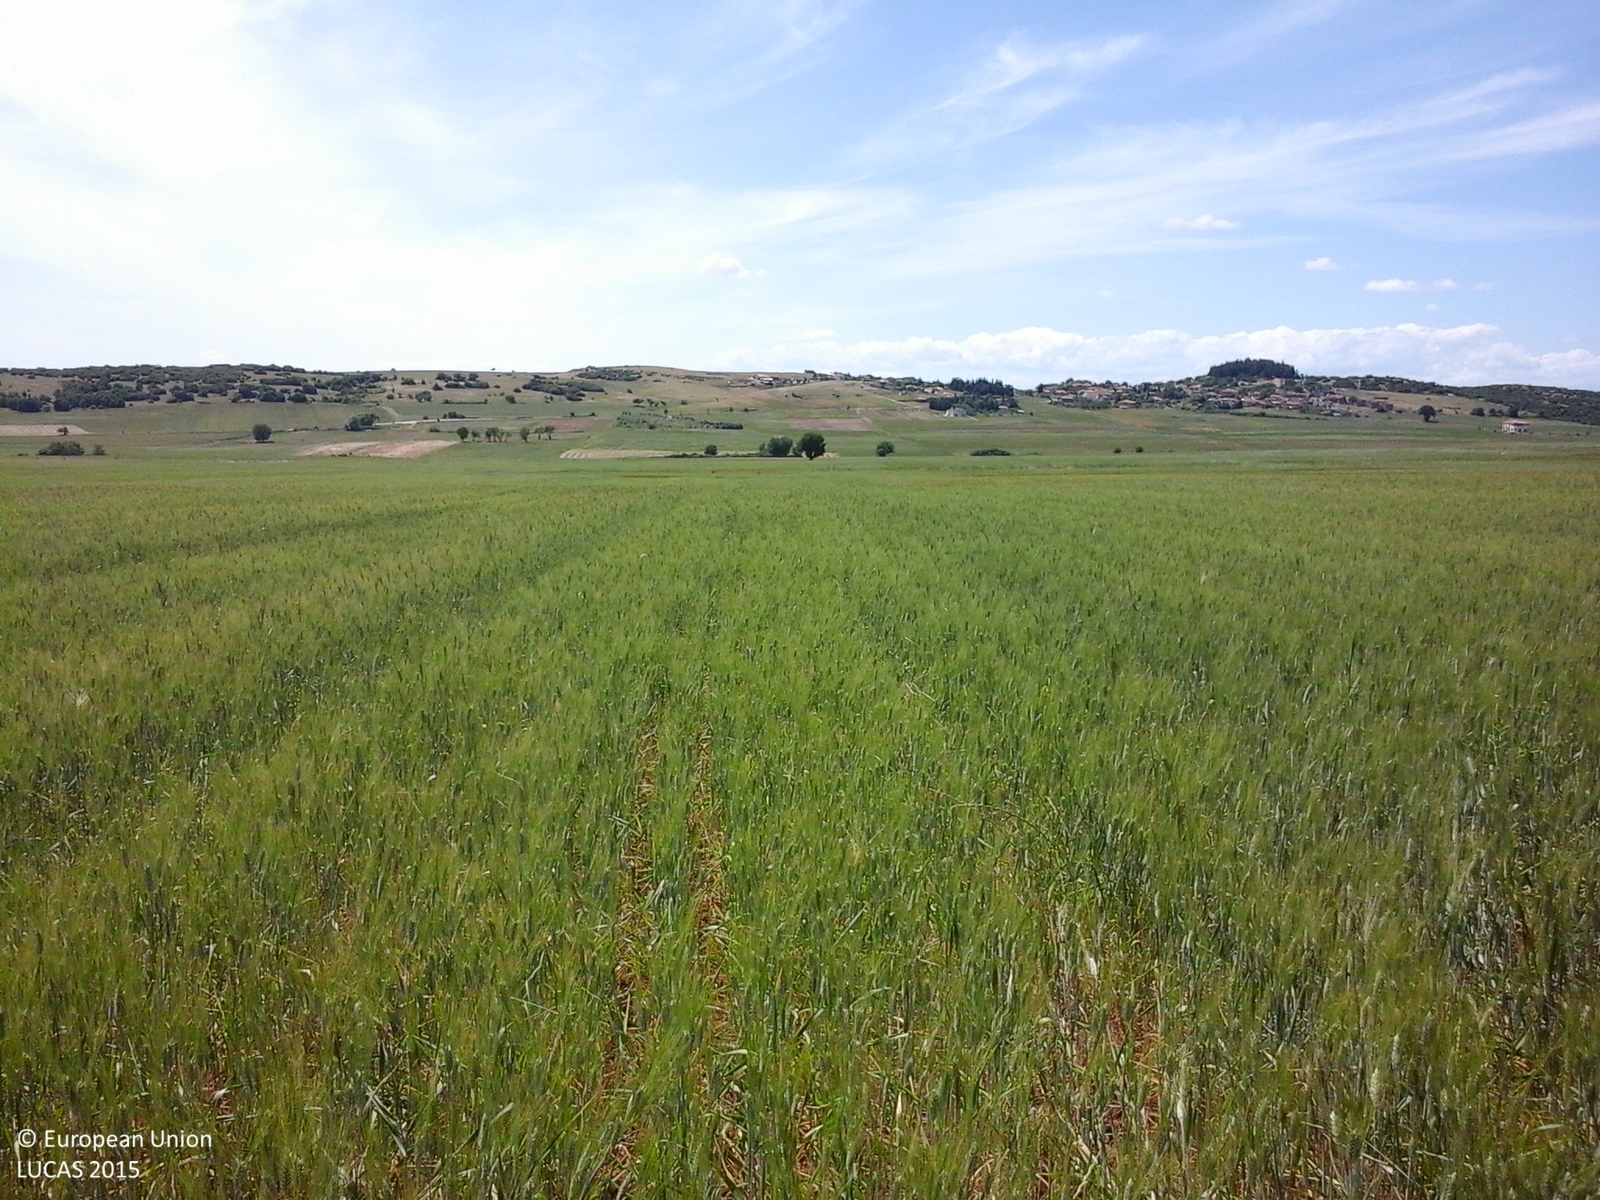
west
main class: Cropland
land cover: Common wheat
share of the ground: > 75 %
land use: Agriculture (excluding fallow land and kitchen gardens)
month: May
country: GR
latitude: 40.8648
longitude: 22.9779
